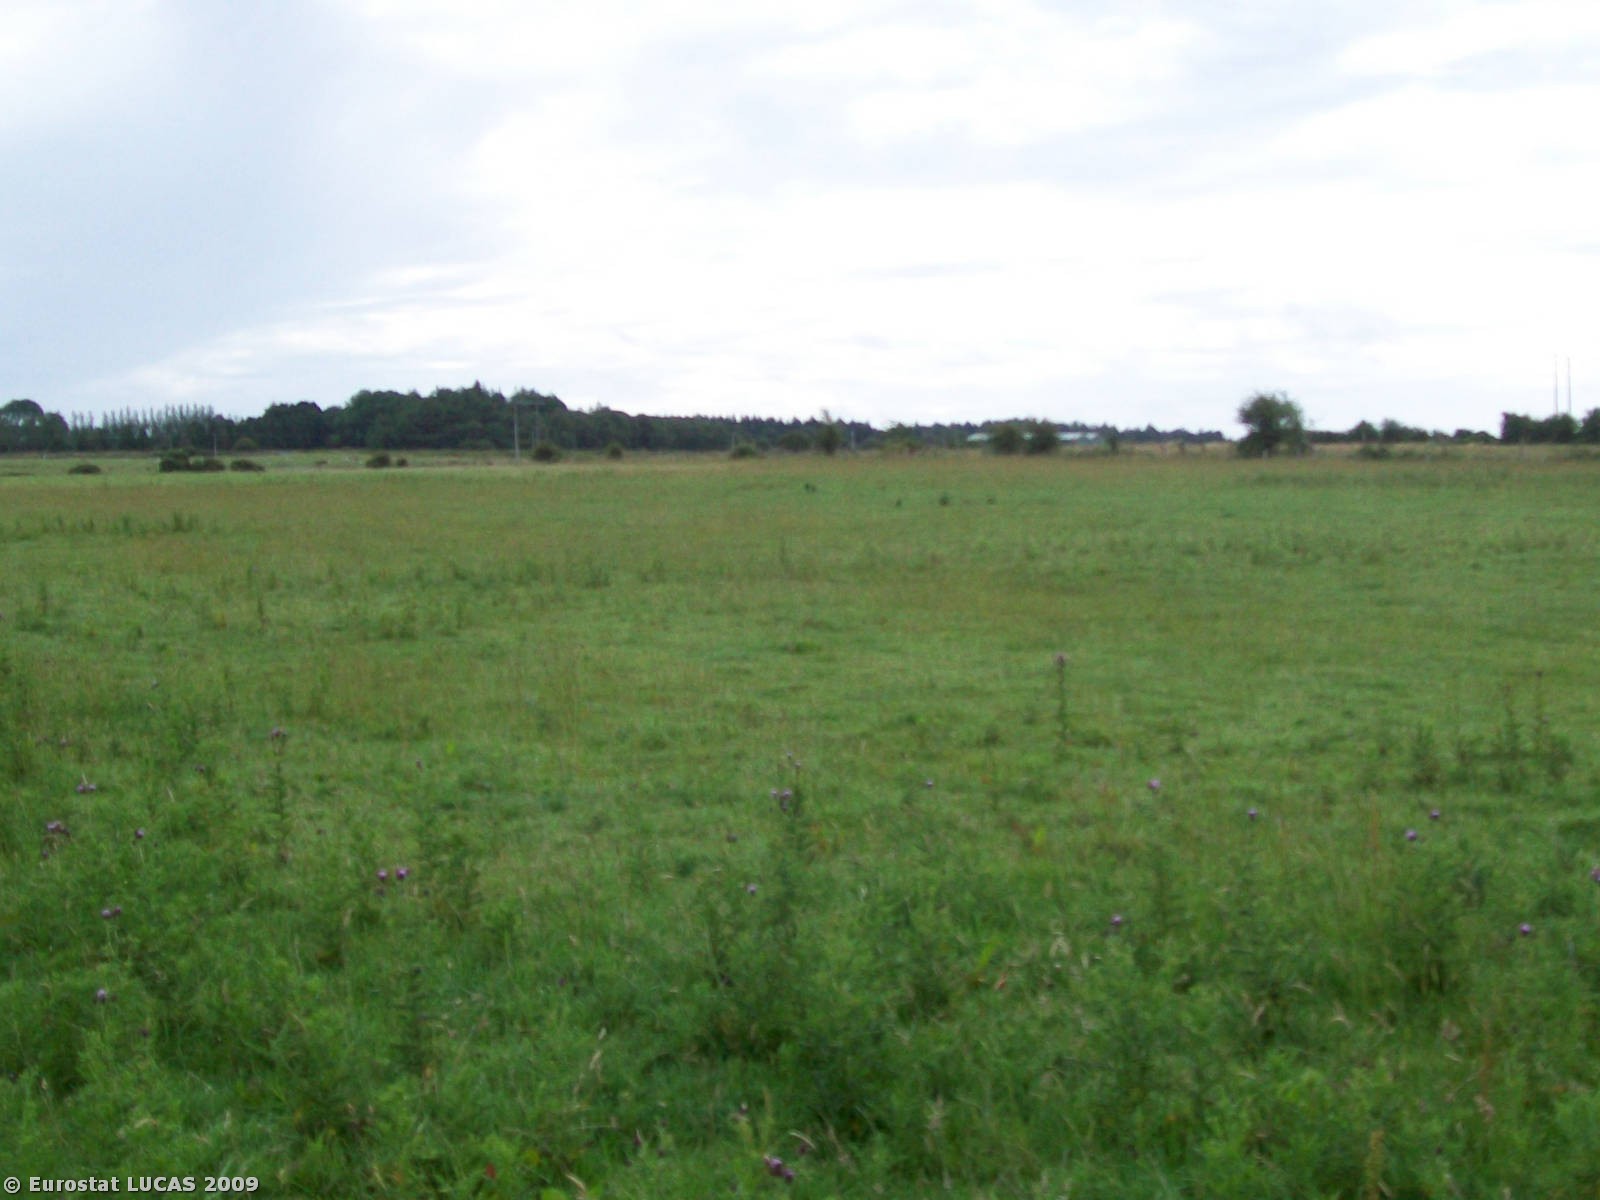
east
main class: Grassland
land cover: Grassland without tree/shrub cover
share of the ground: > 75 %
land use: Agriculture (excluding fallow land and kitchen gardens)
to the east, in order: Grassland without tree/shrub cover; Fences; Ditches and canals; Fences; Grassland without tree/shrub cover
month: July
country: IE
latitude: 53.4920
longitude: -8.8514
